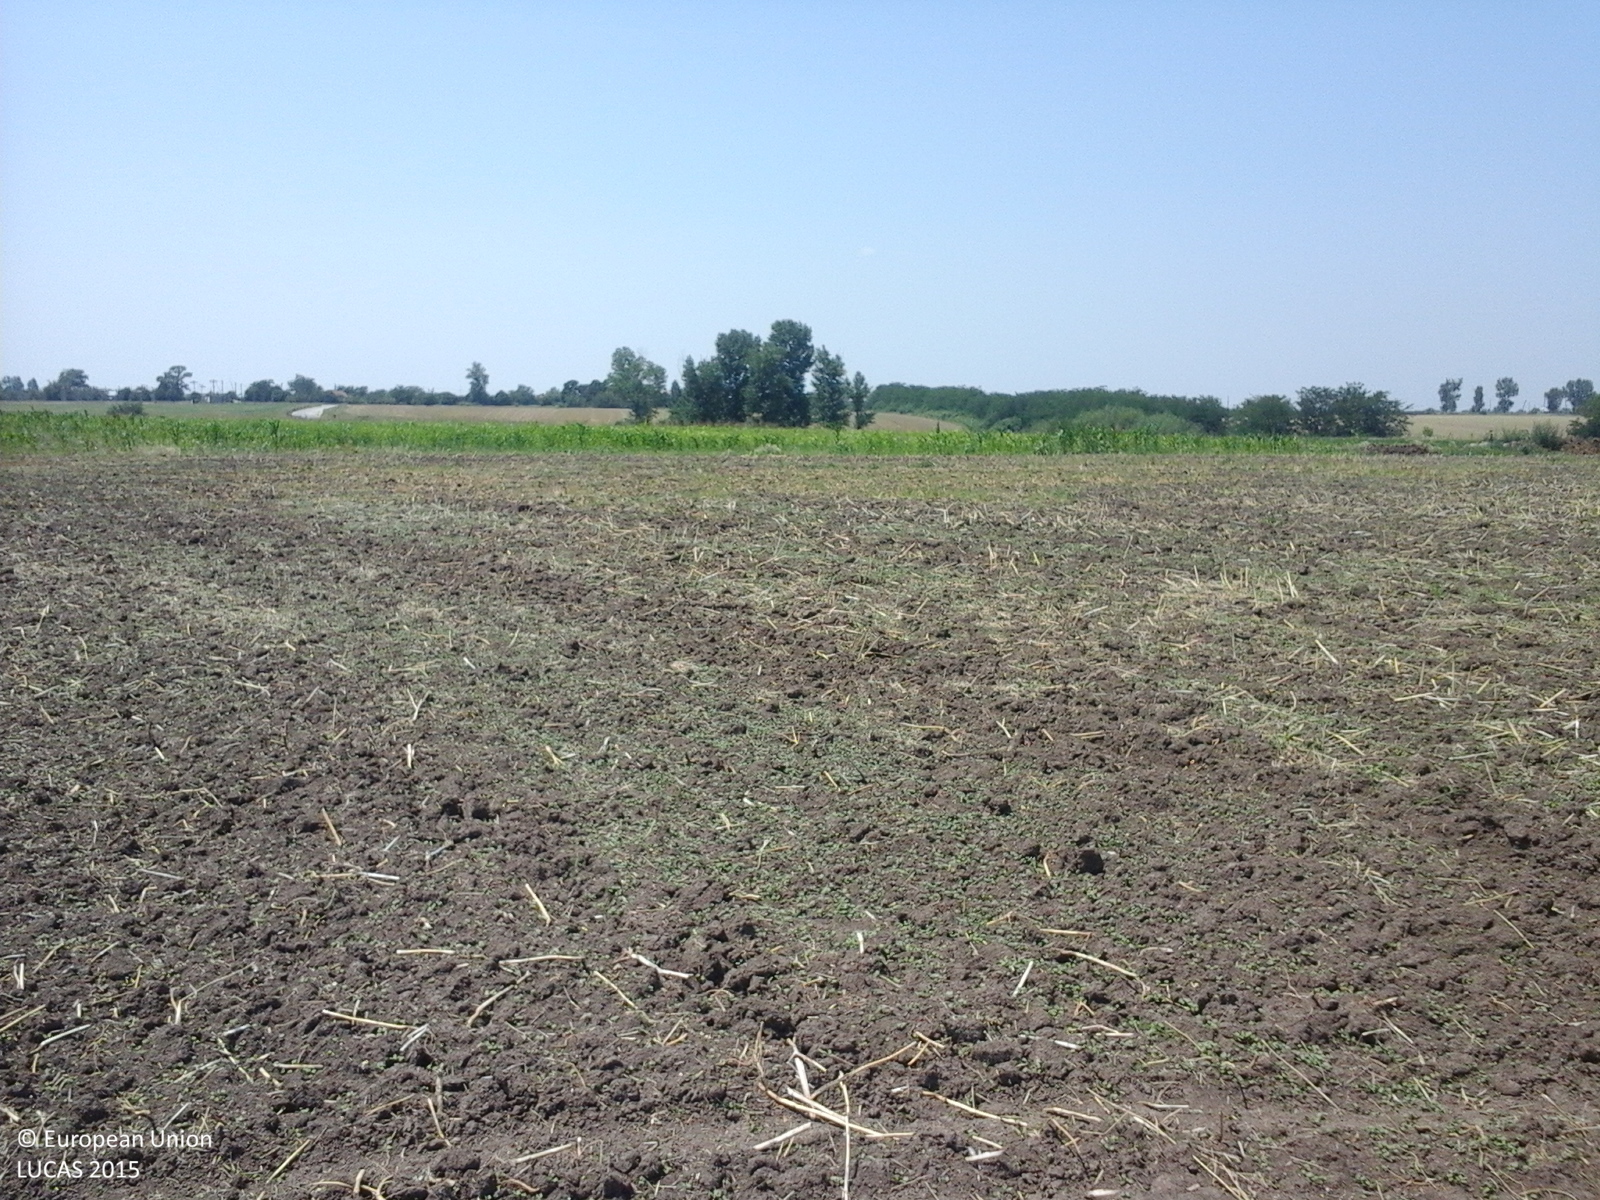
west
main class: Cropland
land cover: Rape and turnip rape
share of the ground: < 10 %
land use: Agriculture (excluding fallow land and kitchen gardens)
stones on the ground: < 10 %
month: July
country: RO
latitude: 44.3562
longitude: 24.9714
